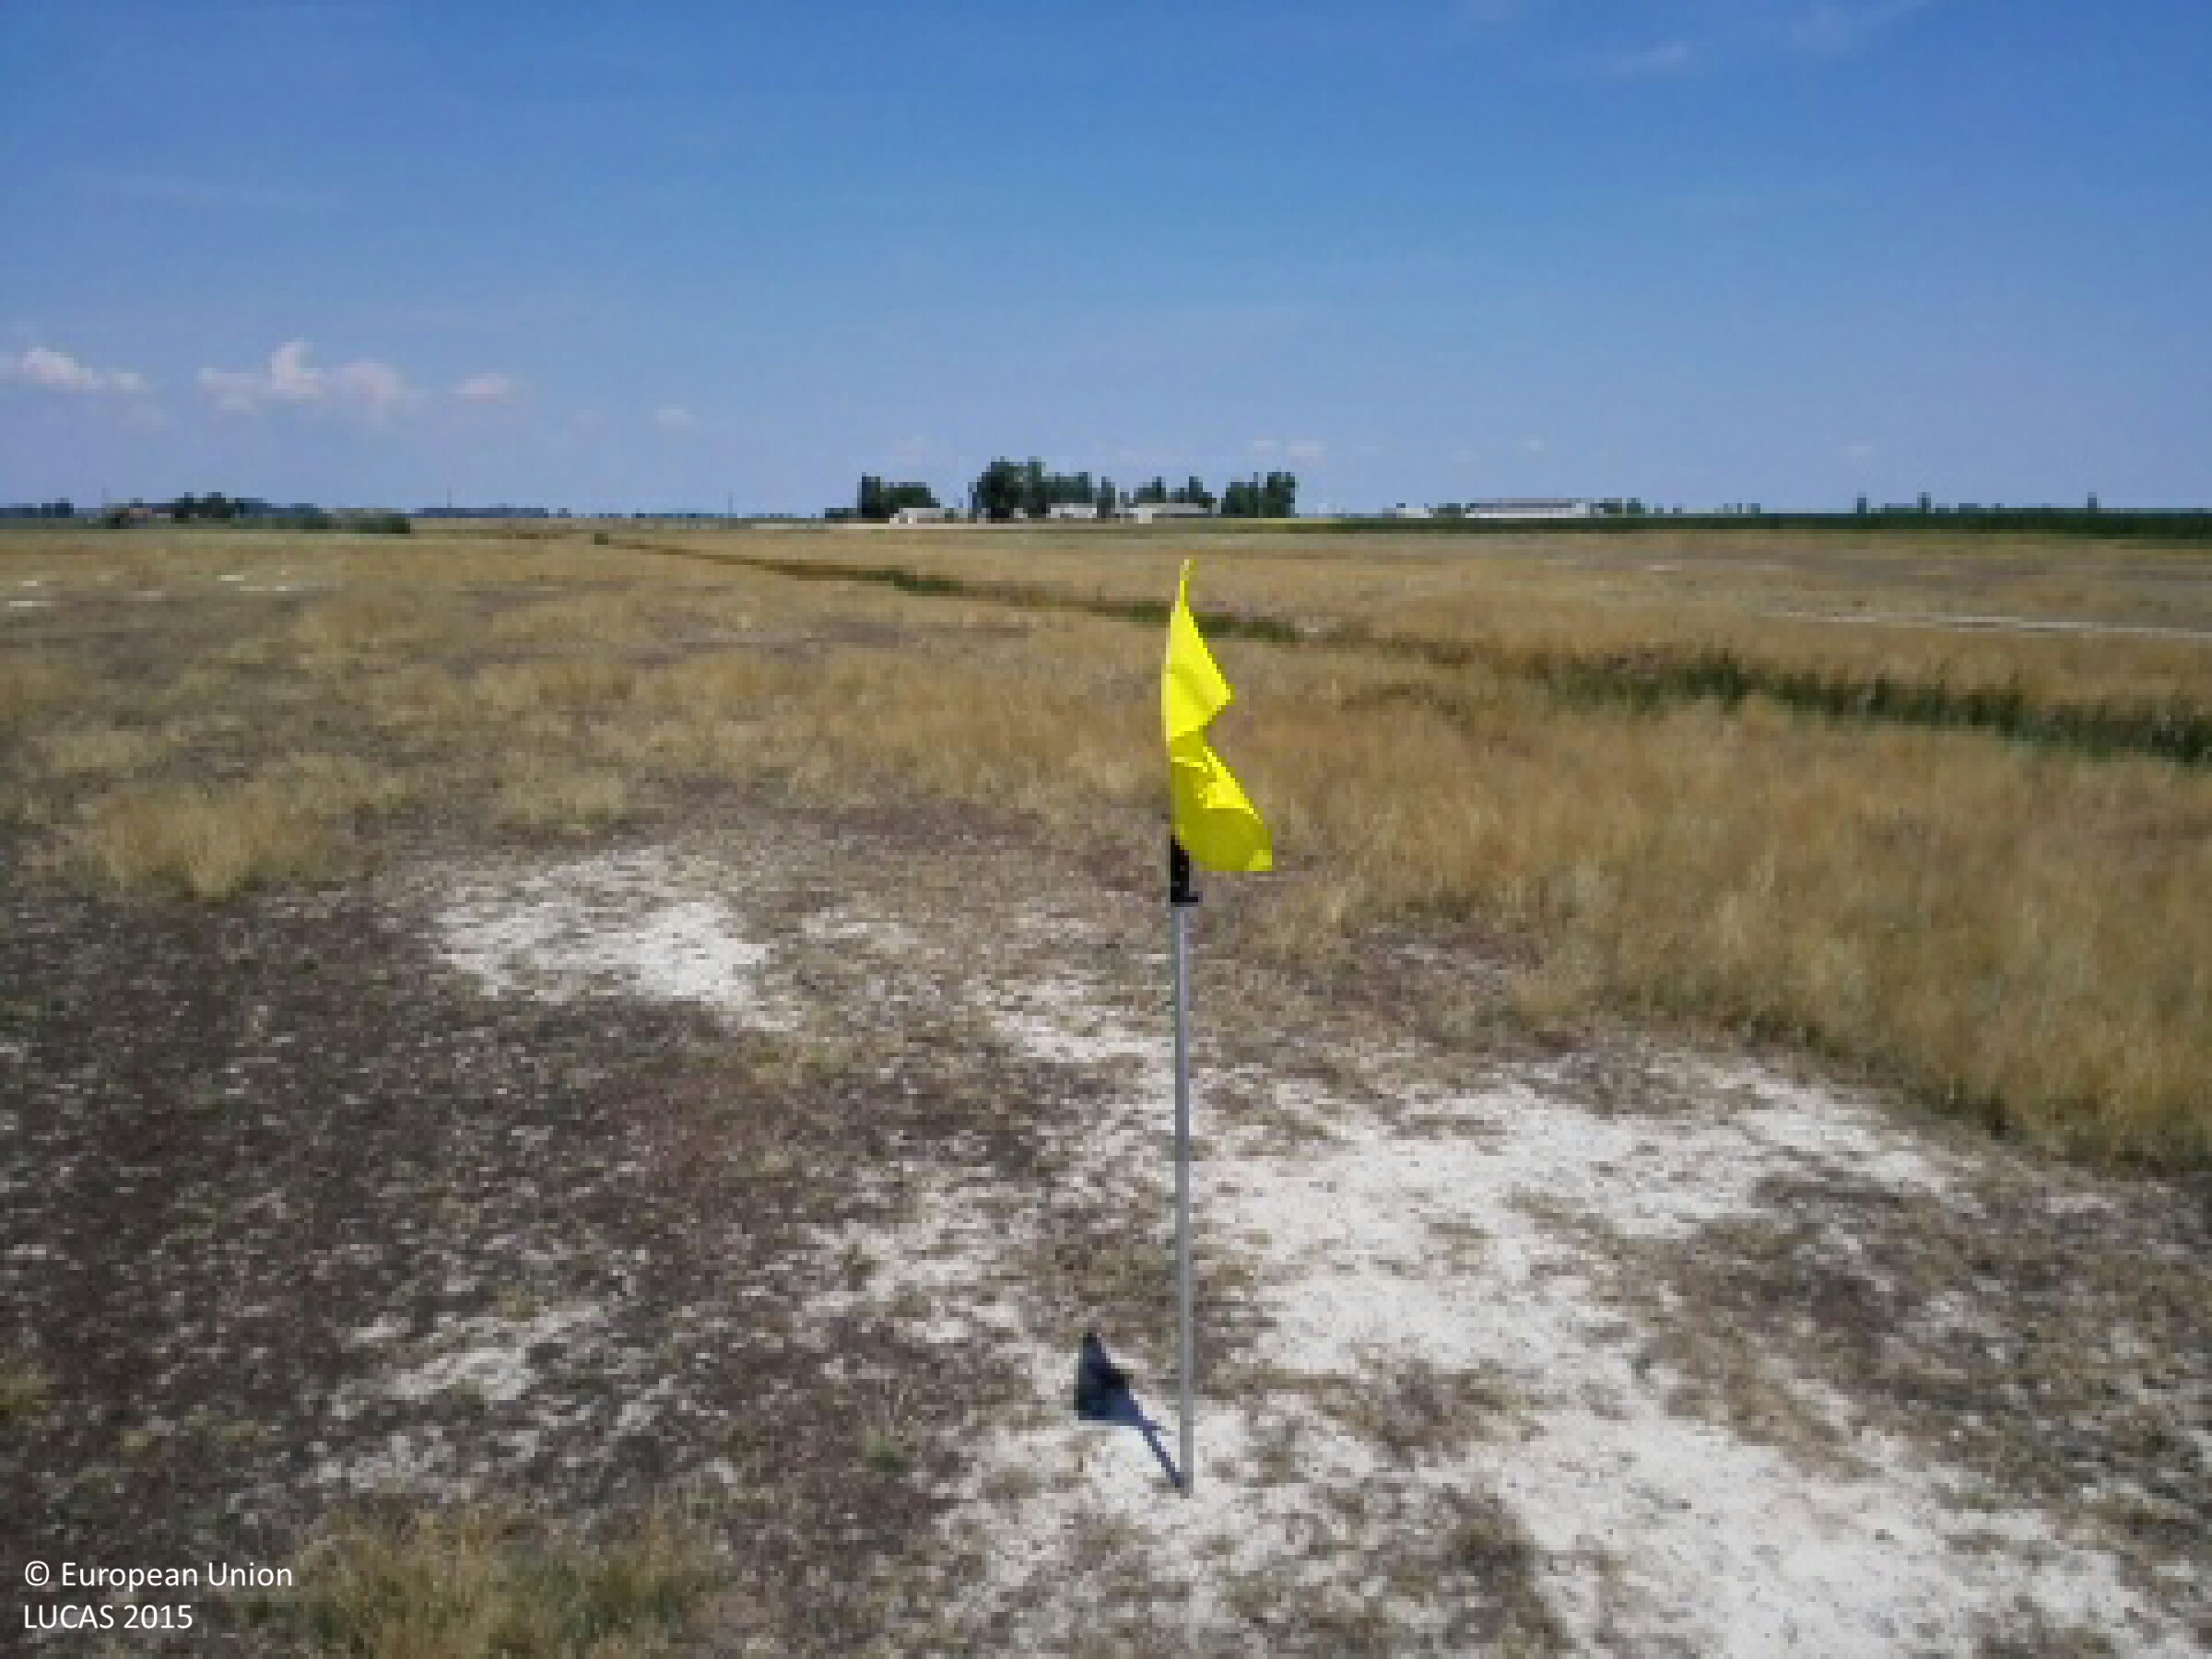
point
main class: Grassland
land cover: Grassland without tree/shrub cover
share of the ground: 25 - 50 %
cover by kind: herbaceous plants 95 %, consolidated bare surface 5 %
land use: Agriculture (excluding fallow land and kitchen gardens)
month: July
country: HU
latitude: 47.7045
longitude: 21.3835
